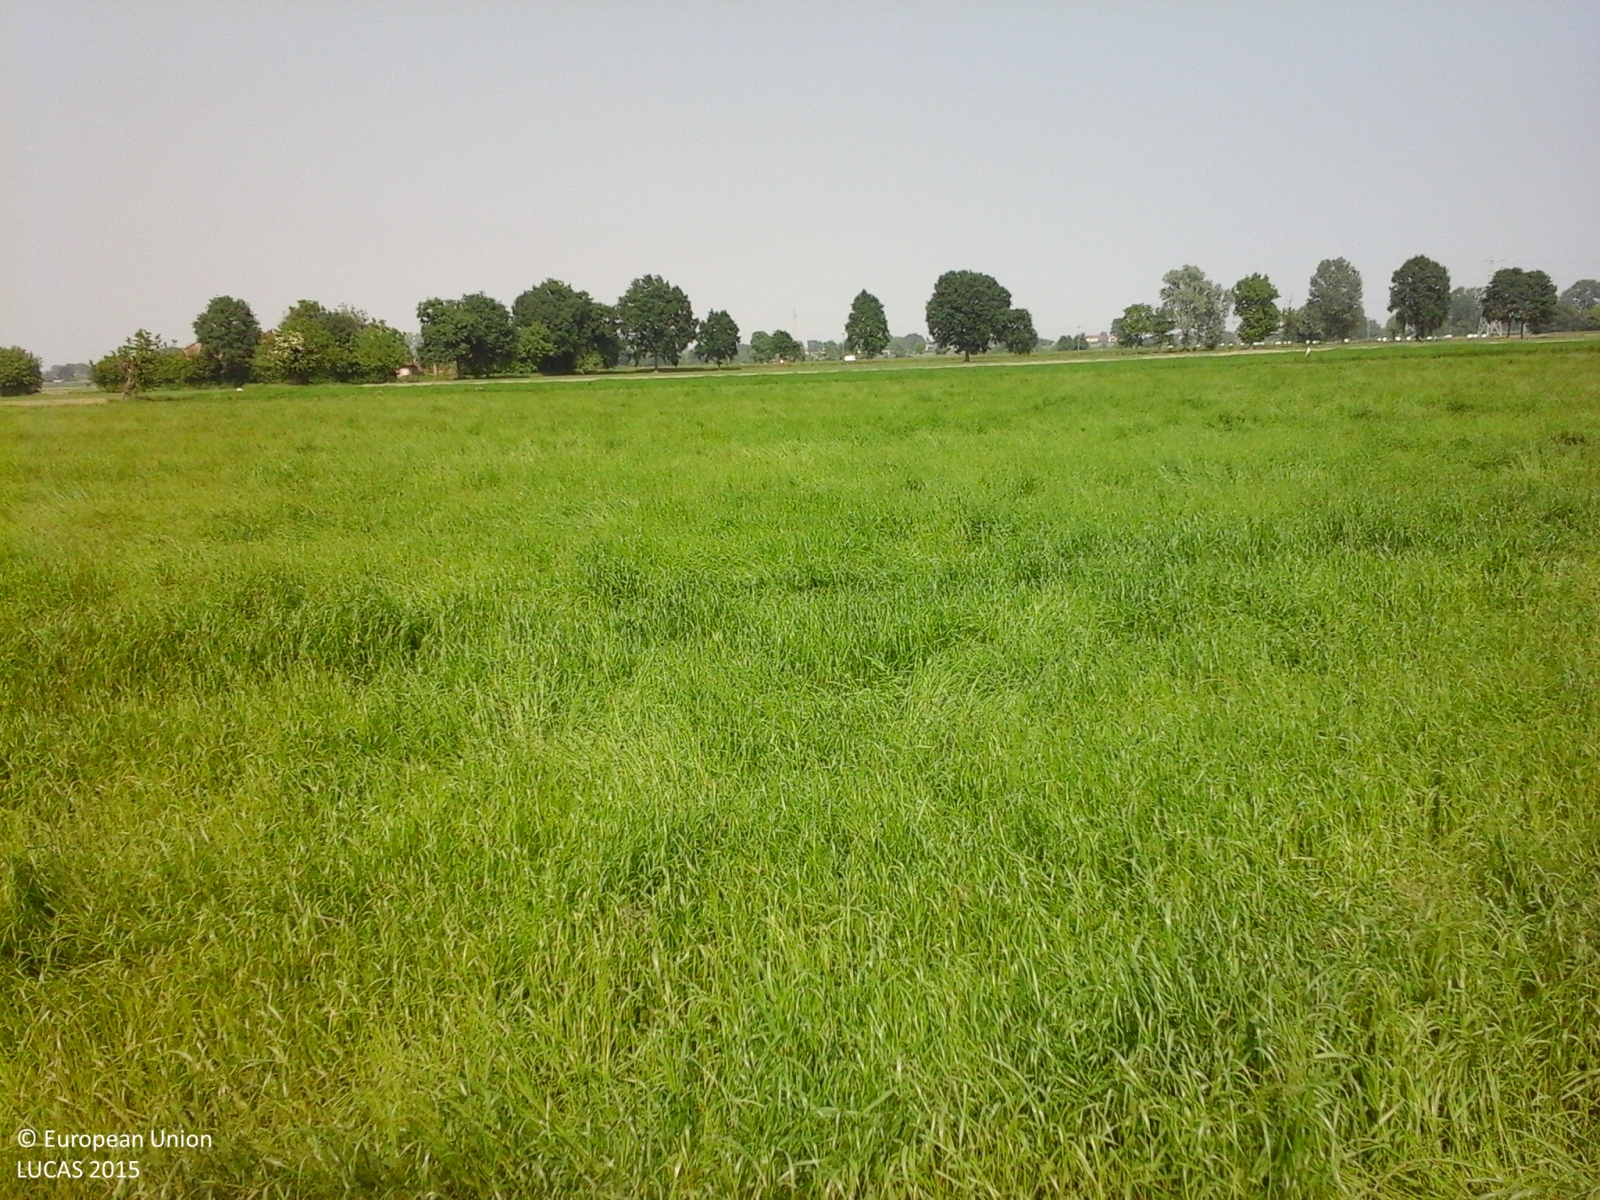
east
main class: Cropland
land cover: Temporary grasslands
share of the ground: > 75 %
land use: Agriculture (excluding fallow land and kitchen gardens)
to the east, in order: Temporary grasslands; Maize; Temporary grasslands; Maize; Temporary grasslands; Maize
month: May
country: IT
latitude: 44.8660
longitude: 7.6882
